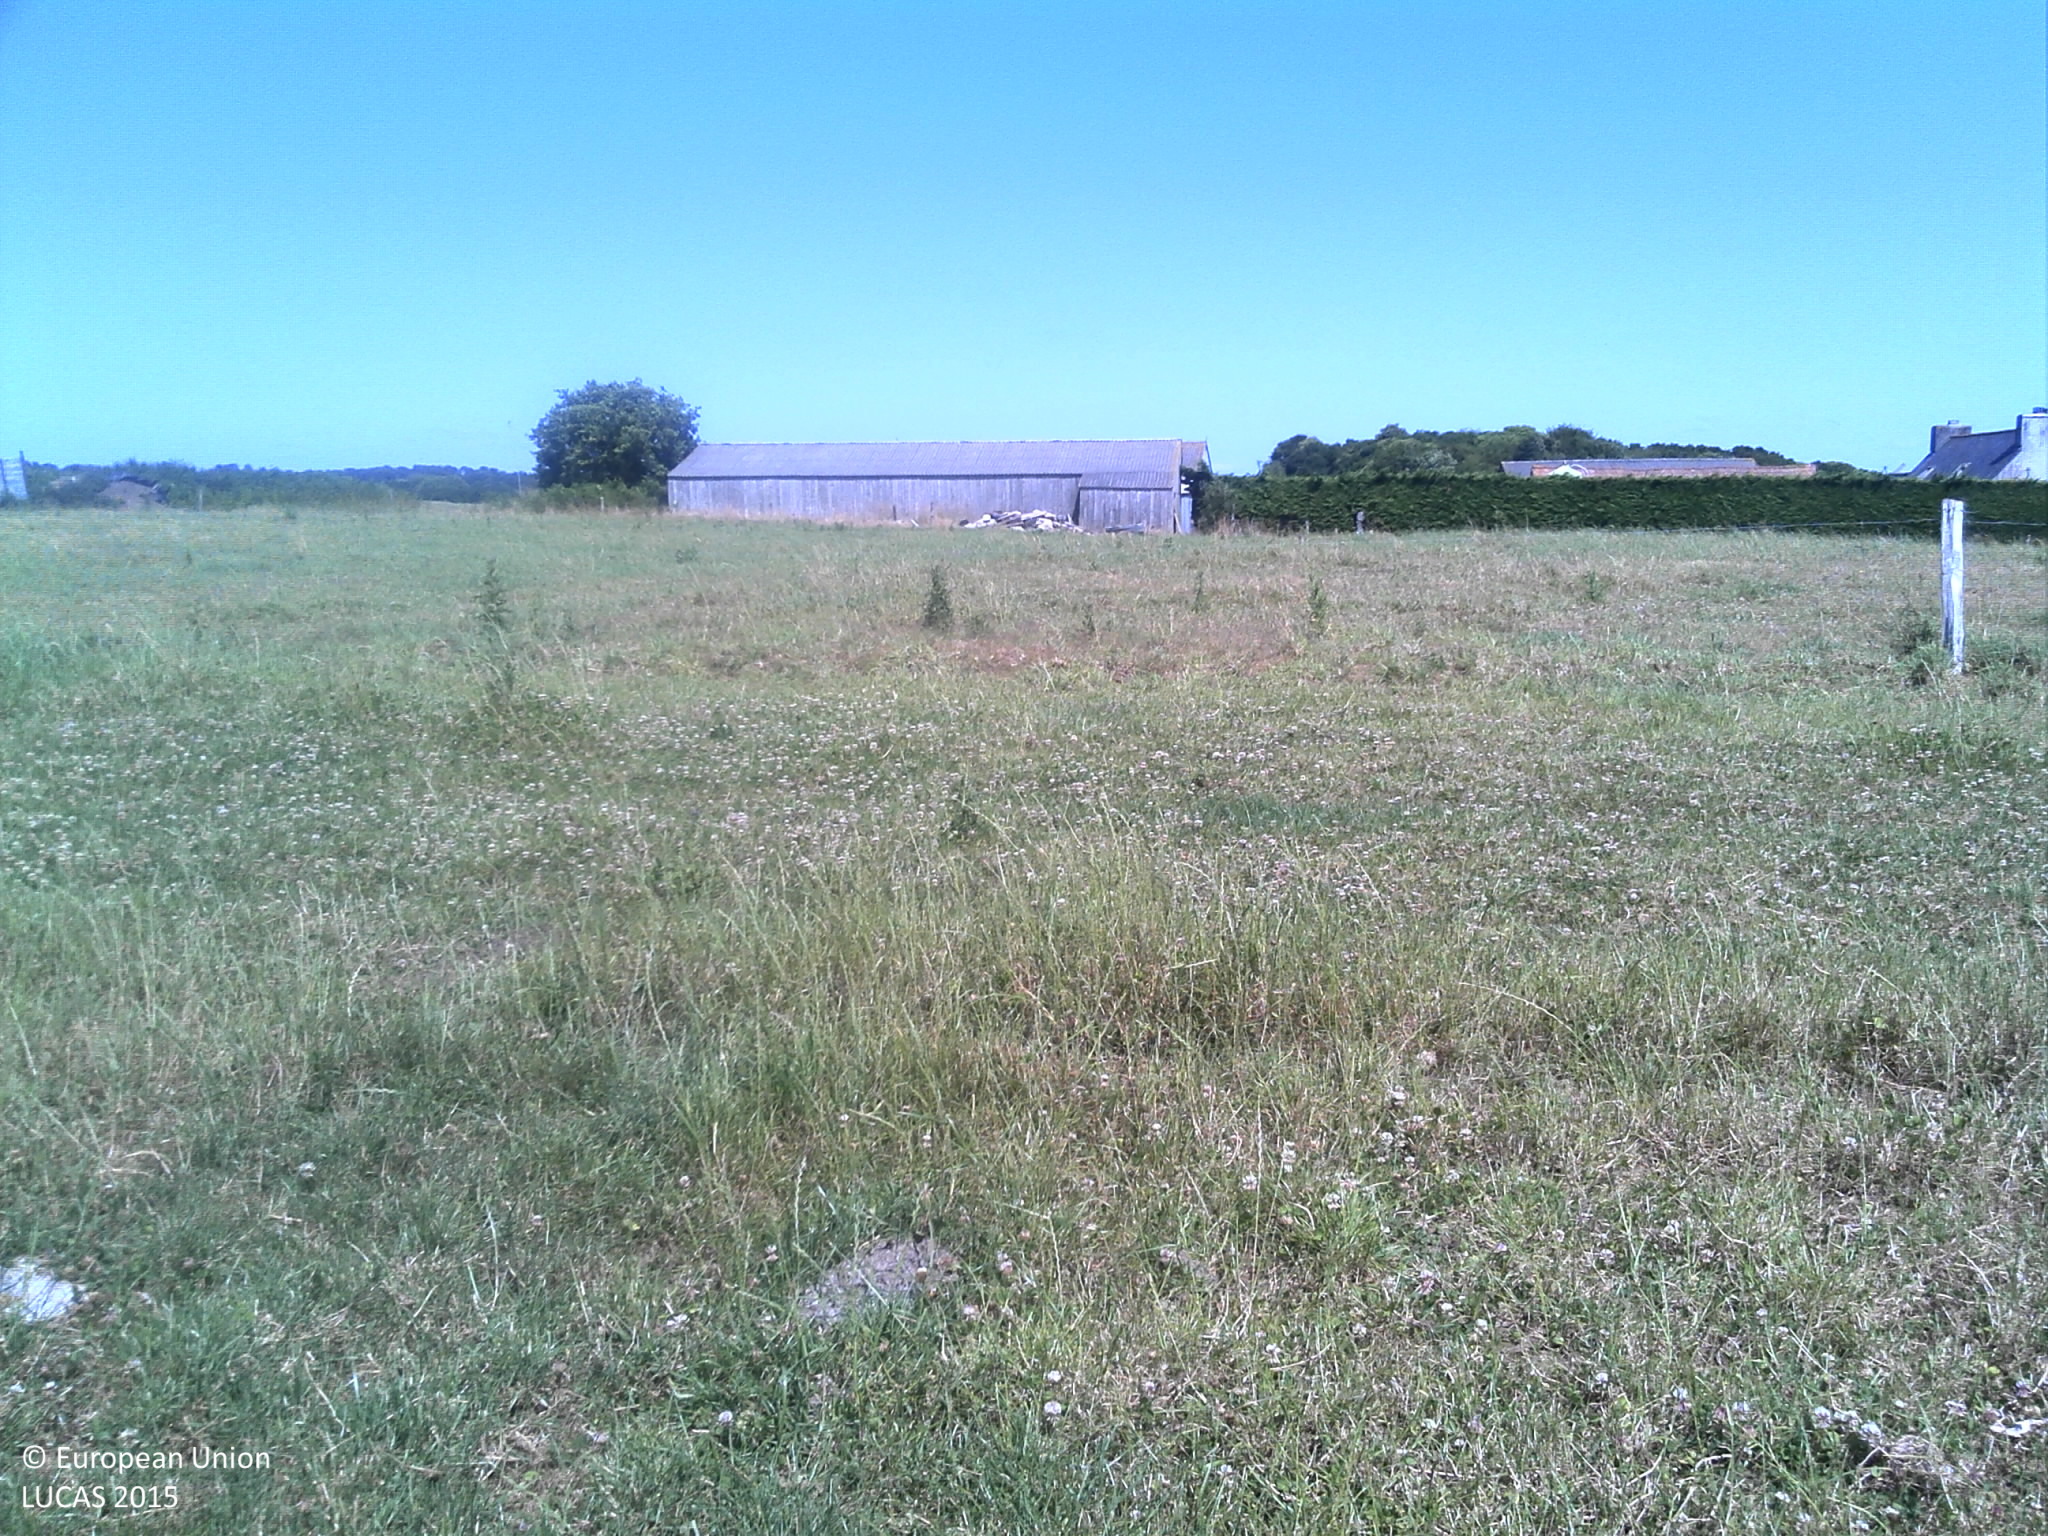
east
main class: Grassland
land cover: Grassland without tree/shrub cover
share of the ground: > 75 %
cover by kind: herbaceous plants 100 %
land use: Agriculture (excluding fallow land and kitchen gardens)
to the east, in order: Grassland without tree/shrub cover; Fences; Grassland without tree/shrub cover; Artificial constructions in urban areas; Grassland without tree/shrub cover; Fences; Grassland without tree/shrub cover
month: July
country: FR
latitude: 48.6168
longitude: -3.7440
